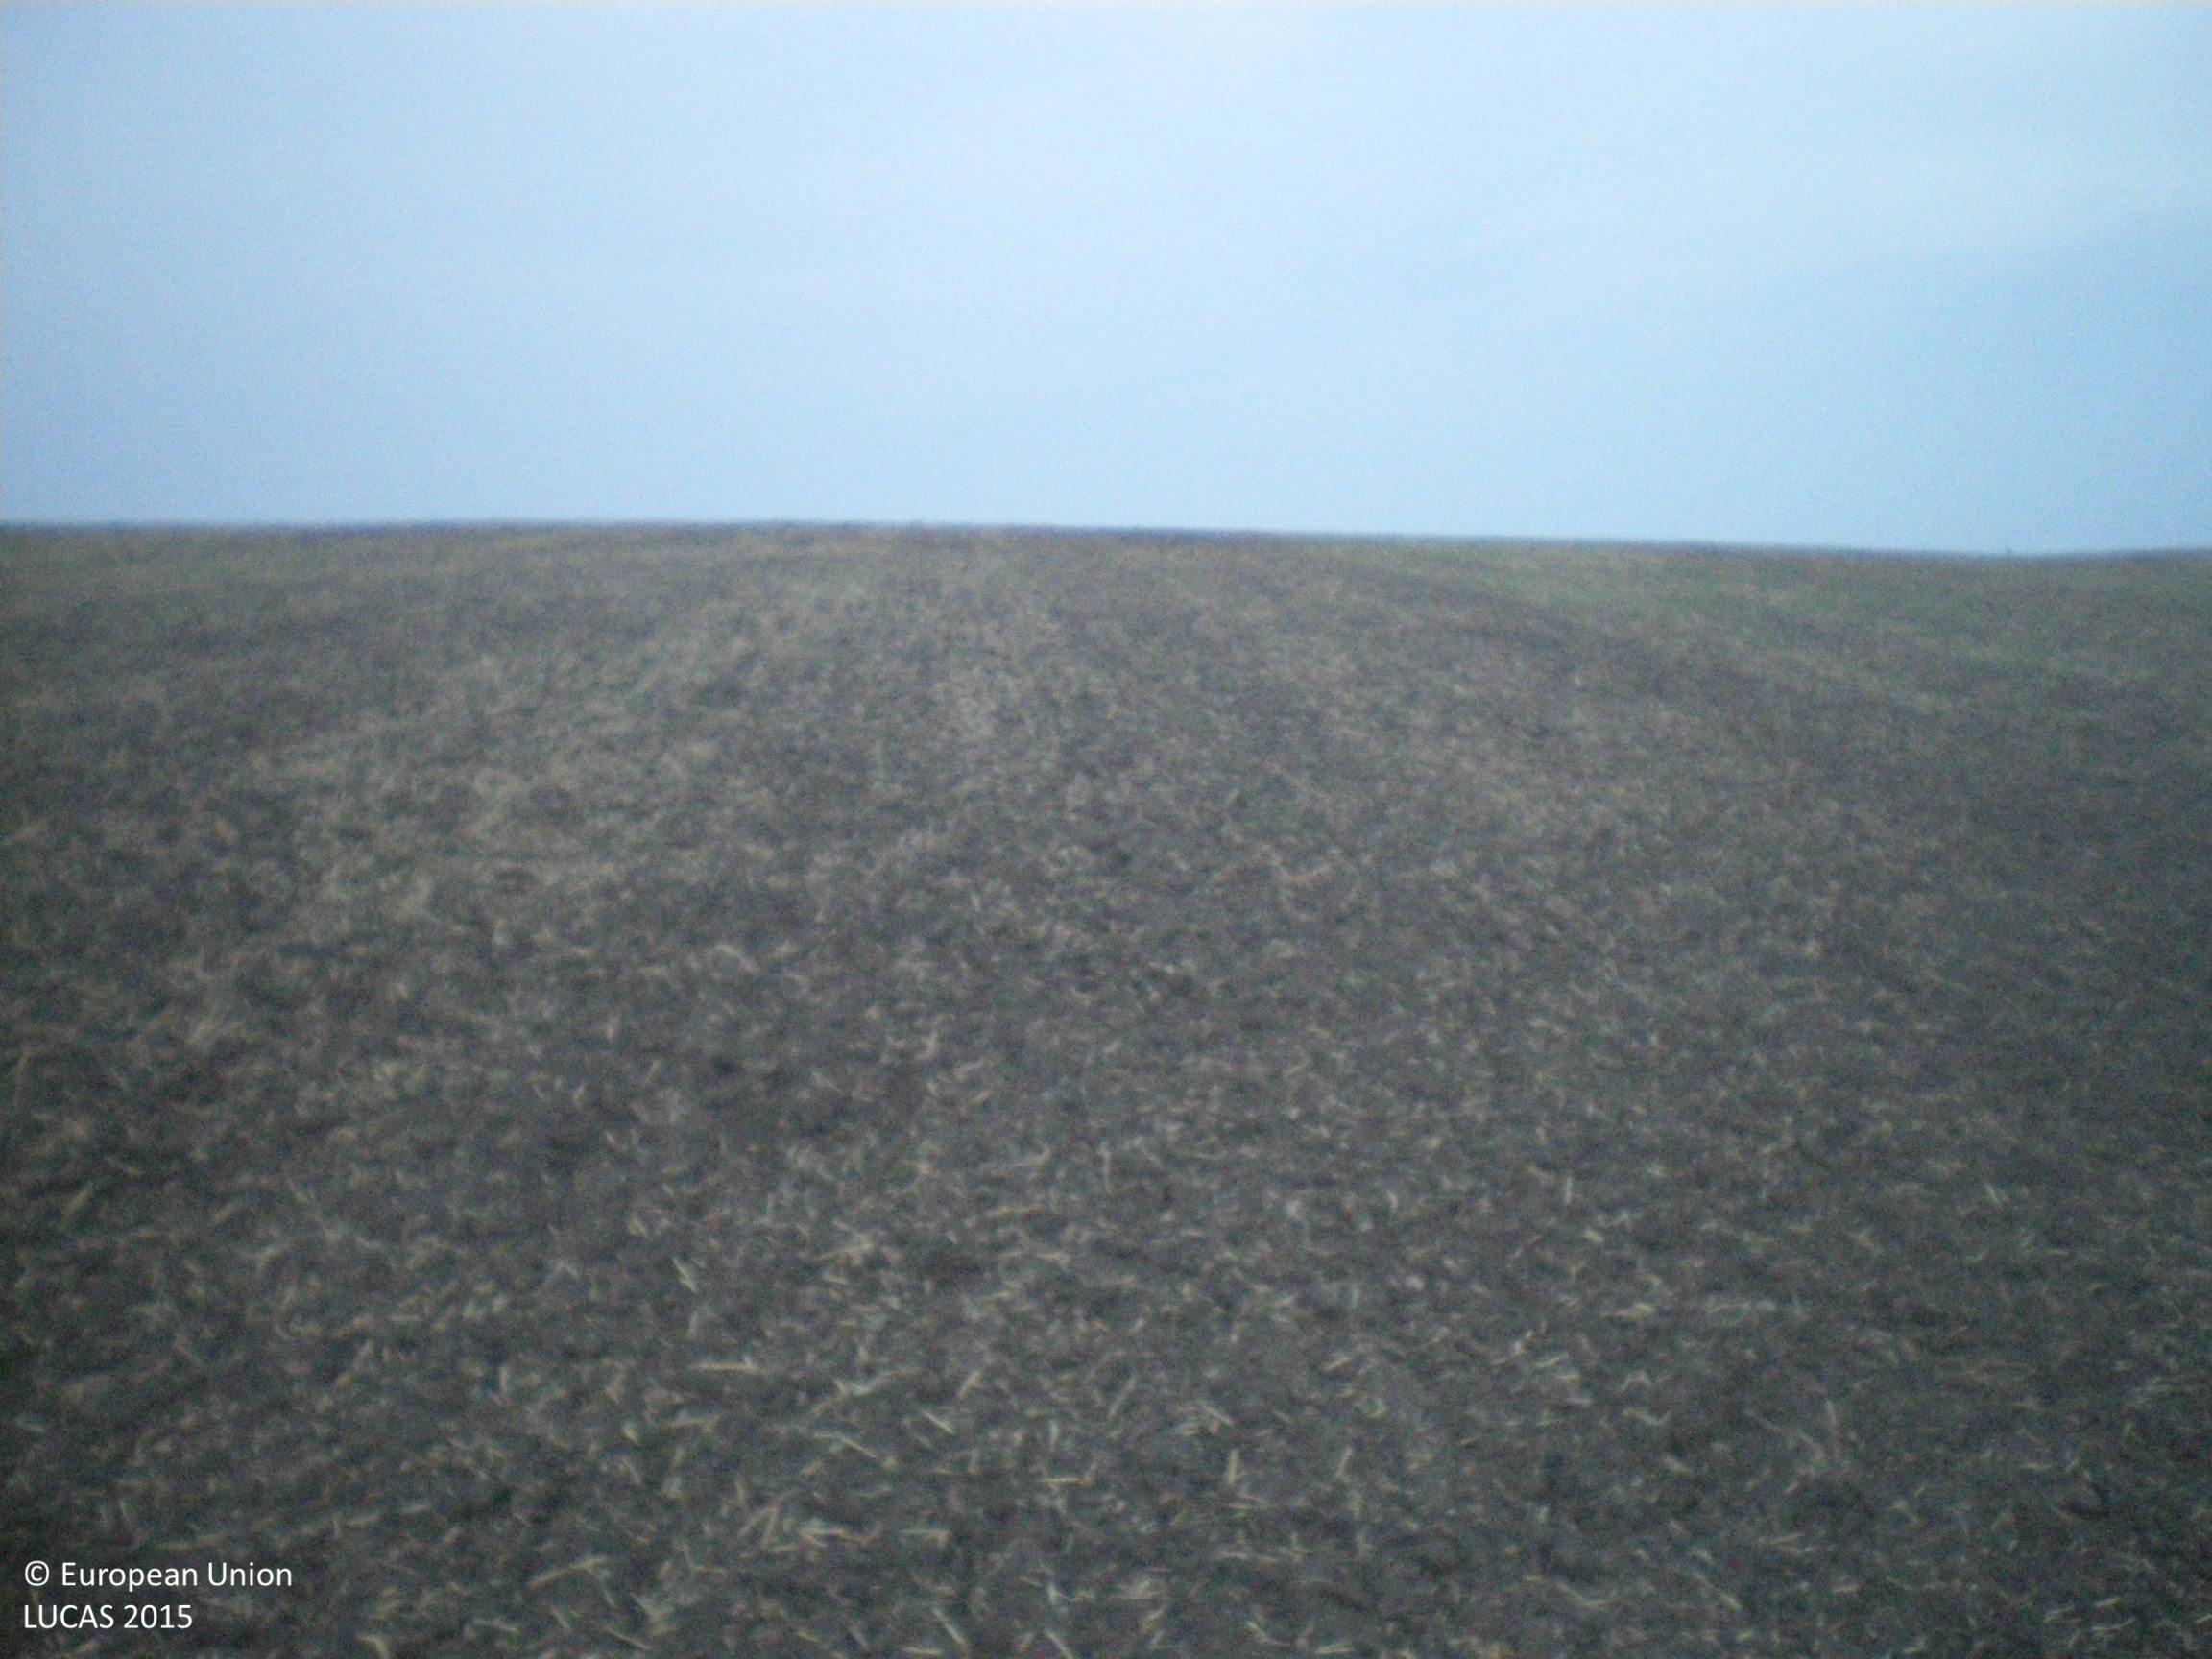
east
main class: Cropland
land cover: Common wheat
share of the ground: < 10 %
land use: Agriculture (excluding fallow land and kitchen gardens)
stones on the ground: < 10 %
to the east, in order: Common wheat
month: September
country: BG
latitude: 42.1223
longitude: 25.9077
